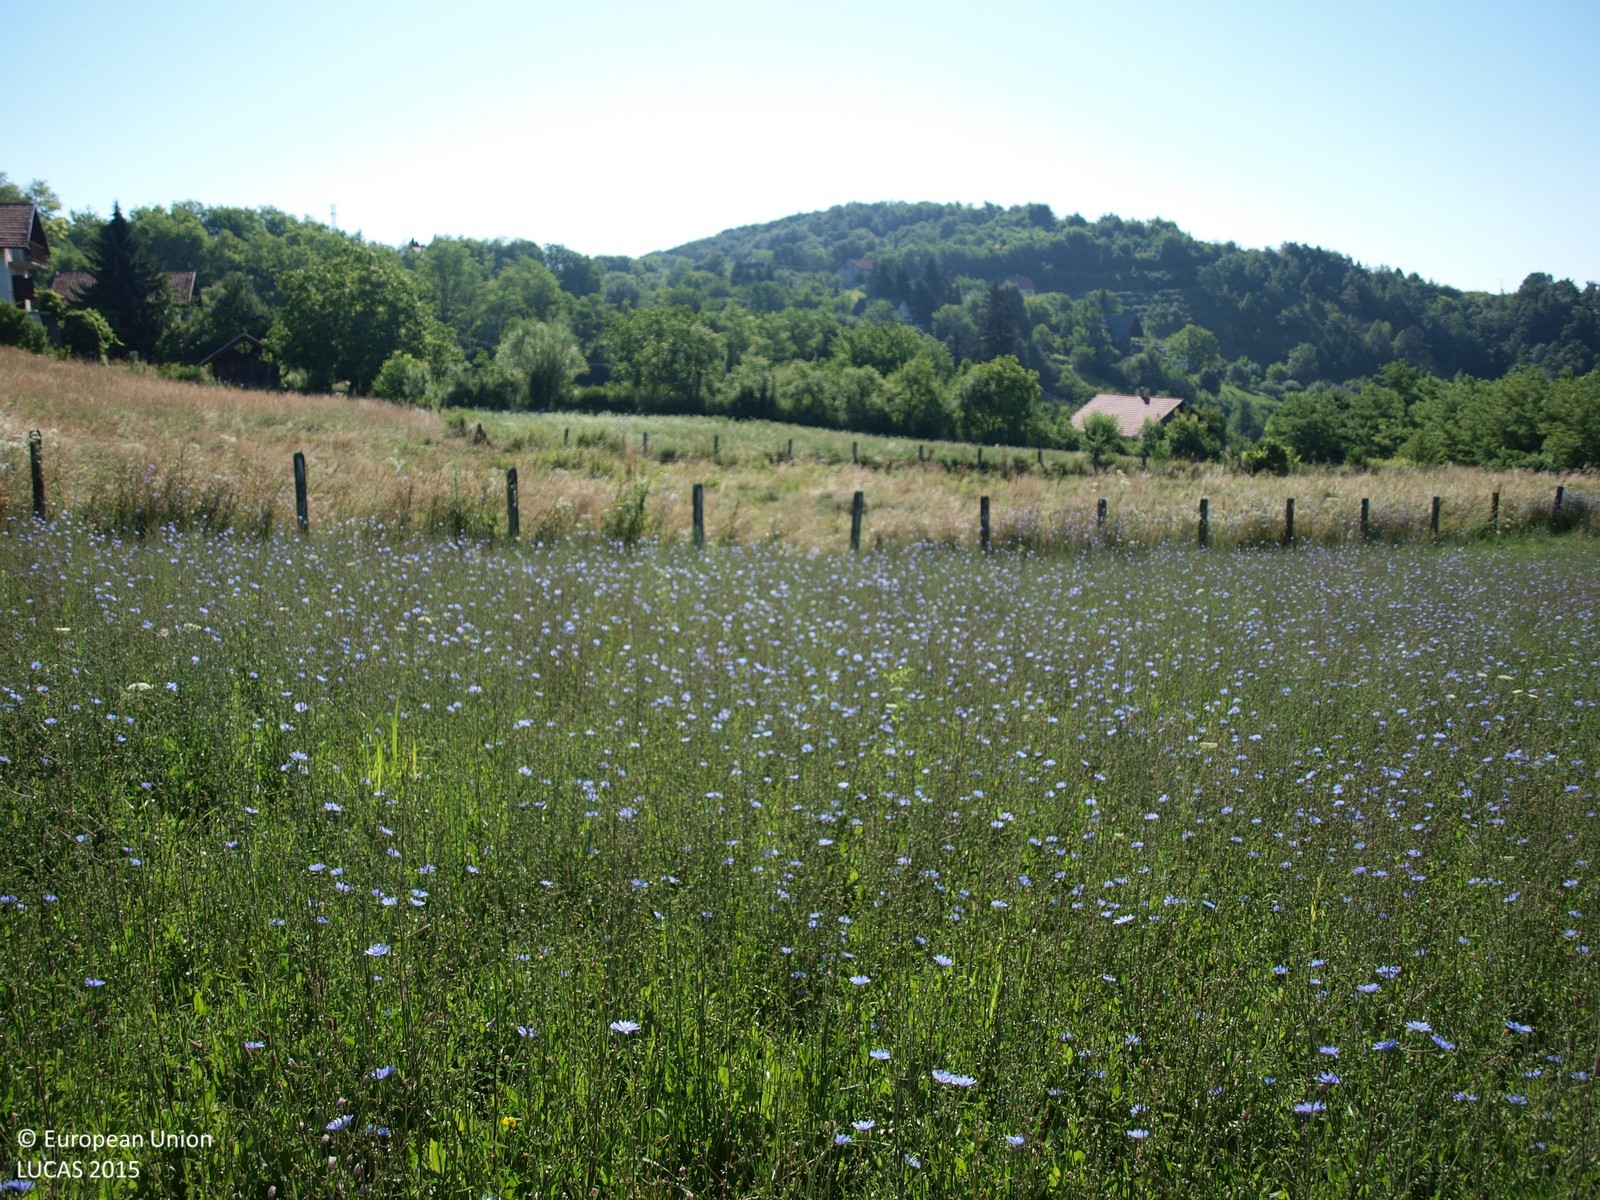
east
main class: Grassland
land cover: Grassland without tree/shrub cover
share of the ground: > 75 %
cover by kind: herbaceous plants 100 %
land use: Agriculture (excluding fallow land and kitchen gardens)
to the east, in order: Grassland without tree/shrub cover; Fences; Grassland without tree/shrub cover; Fences; Grassland without tree/shrub cover; Fences; Nuts trees; Fences; Grassland without tree/shrub cover; Tracks; Grassland without tree/shrub cover; Paved roads, cycling and walking lanes; Abandoned hedges; Fences; Nuts trees; Grassland without tree/shrub cover; Nuts trees; Artificial constructions in urban areas
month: July
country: HR
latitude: 45.8919
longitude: 15.7067
